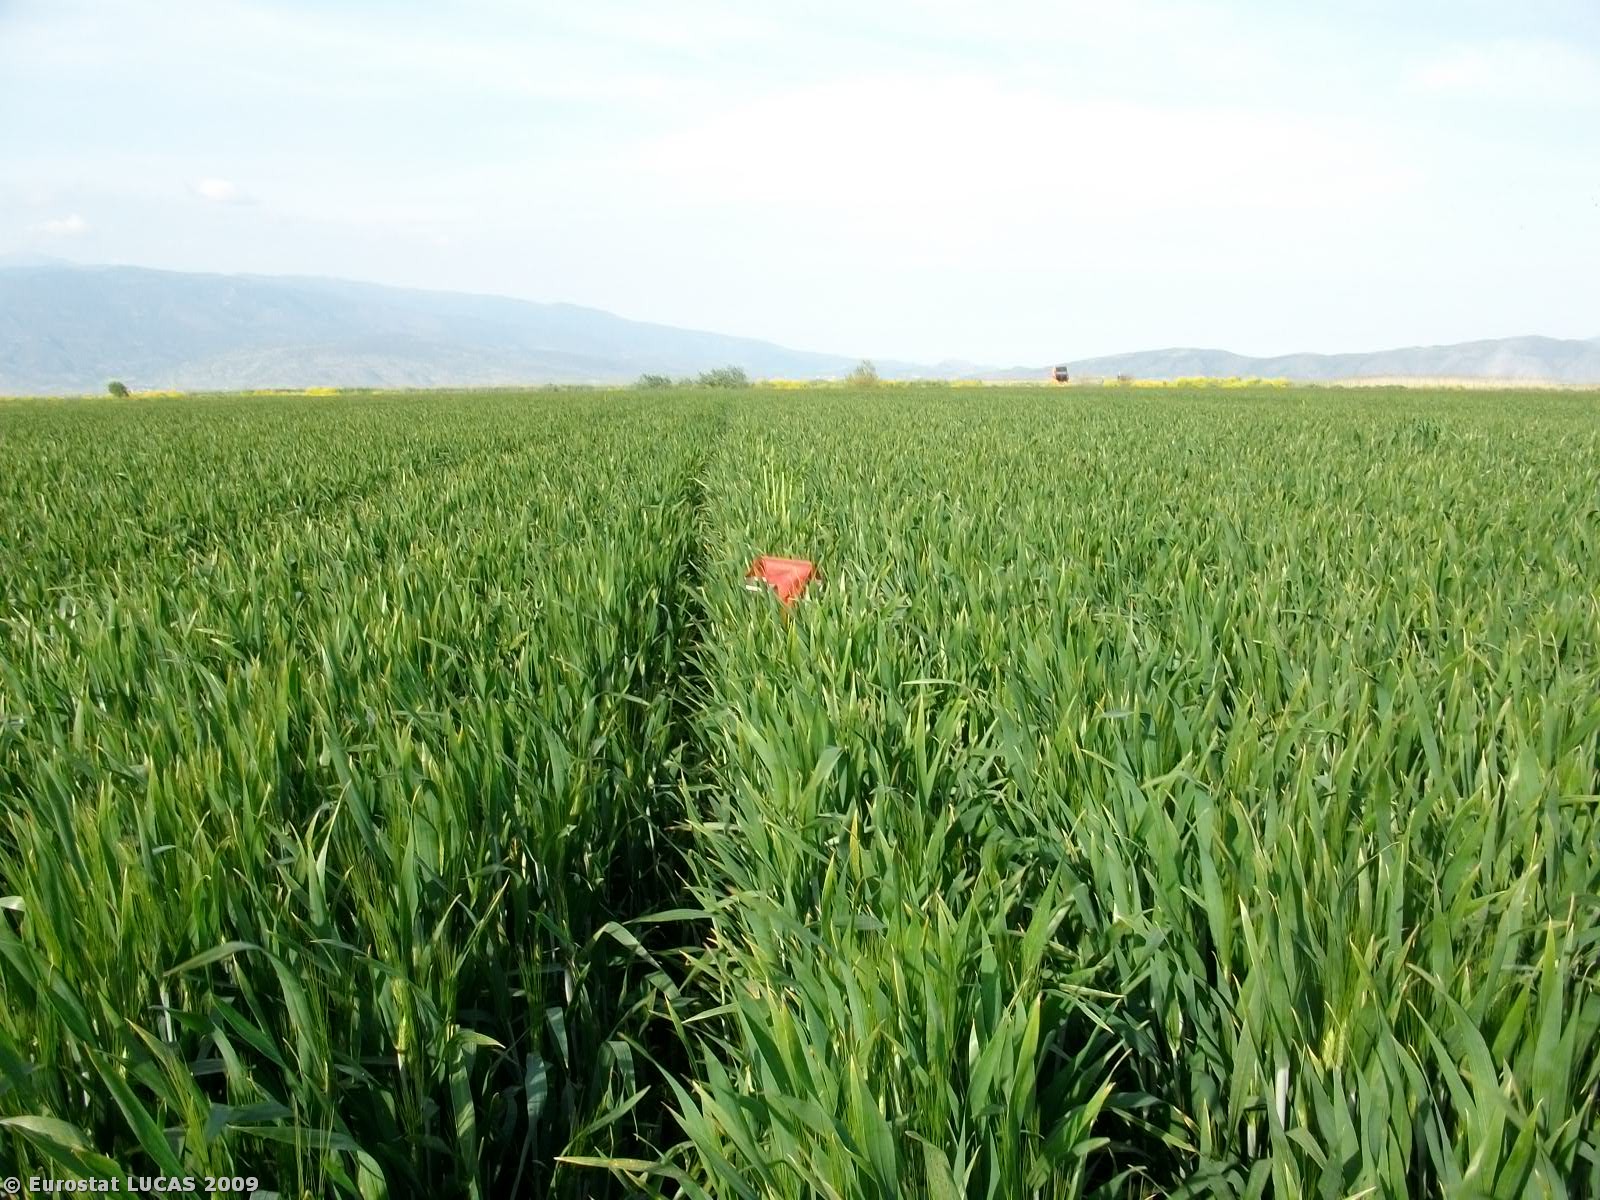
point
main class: Cropland
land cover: Durum wheat
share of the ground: > 75 %
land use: Agriculture (excluding fallow land and kitchen gardens)
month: April
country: GR
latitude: 39.6183
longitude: 22.5834
